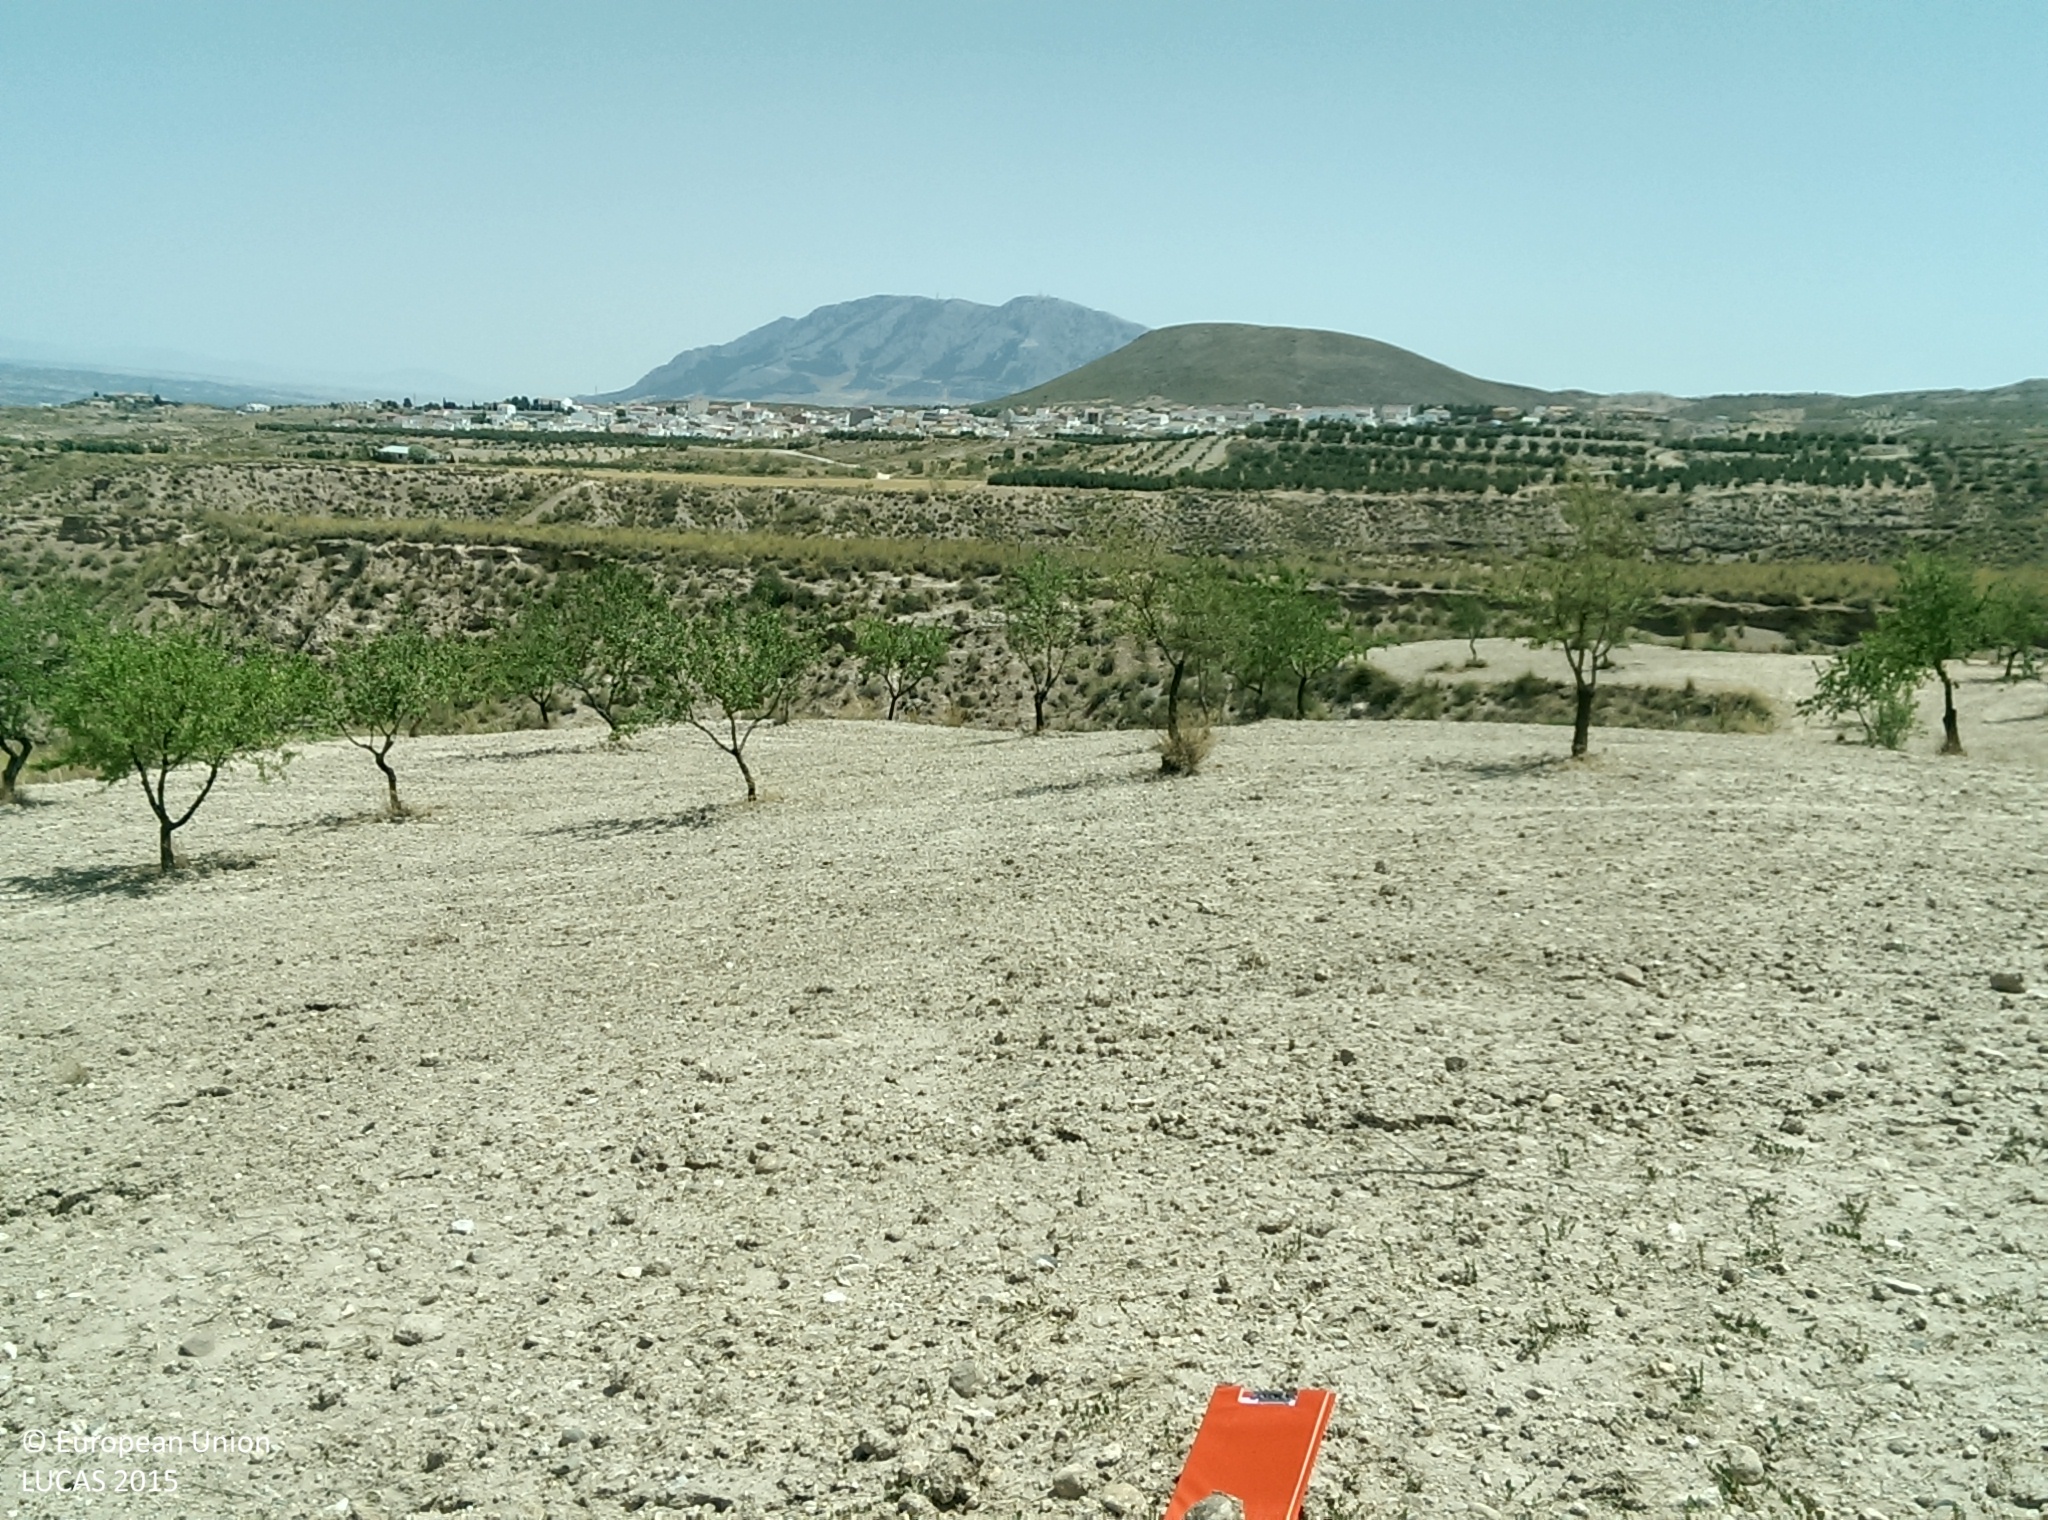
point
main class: Cropland
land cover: Nuts trees
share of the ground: < 10 %
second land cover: Other bare soil
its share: > 75 %
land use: Agriculture (excluding fallow land and kitchen gardens)
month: July
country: ES
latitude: 37.5222
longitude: -2.9216
